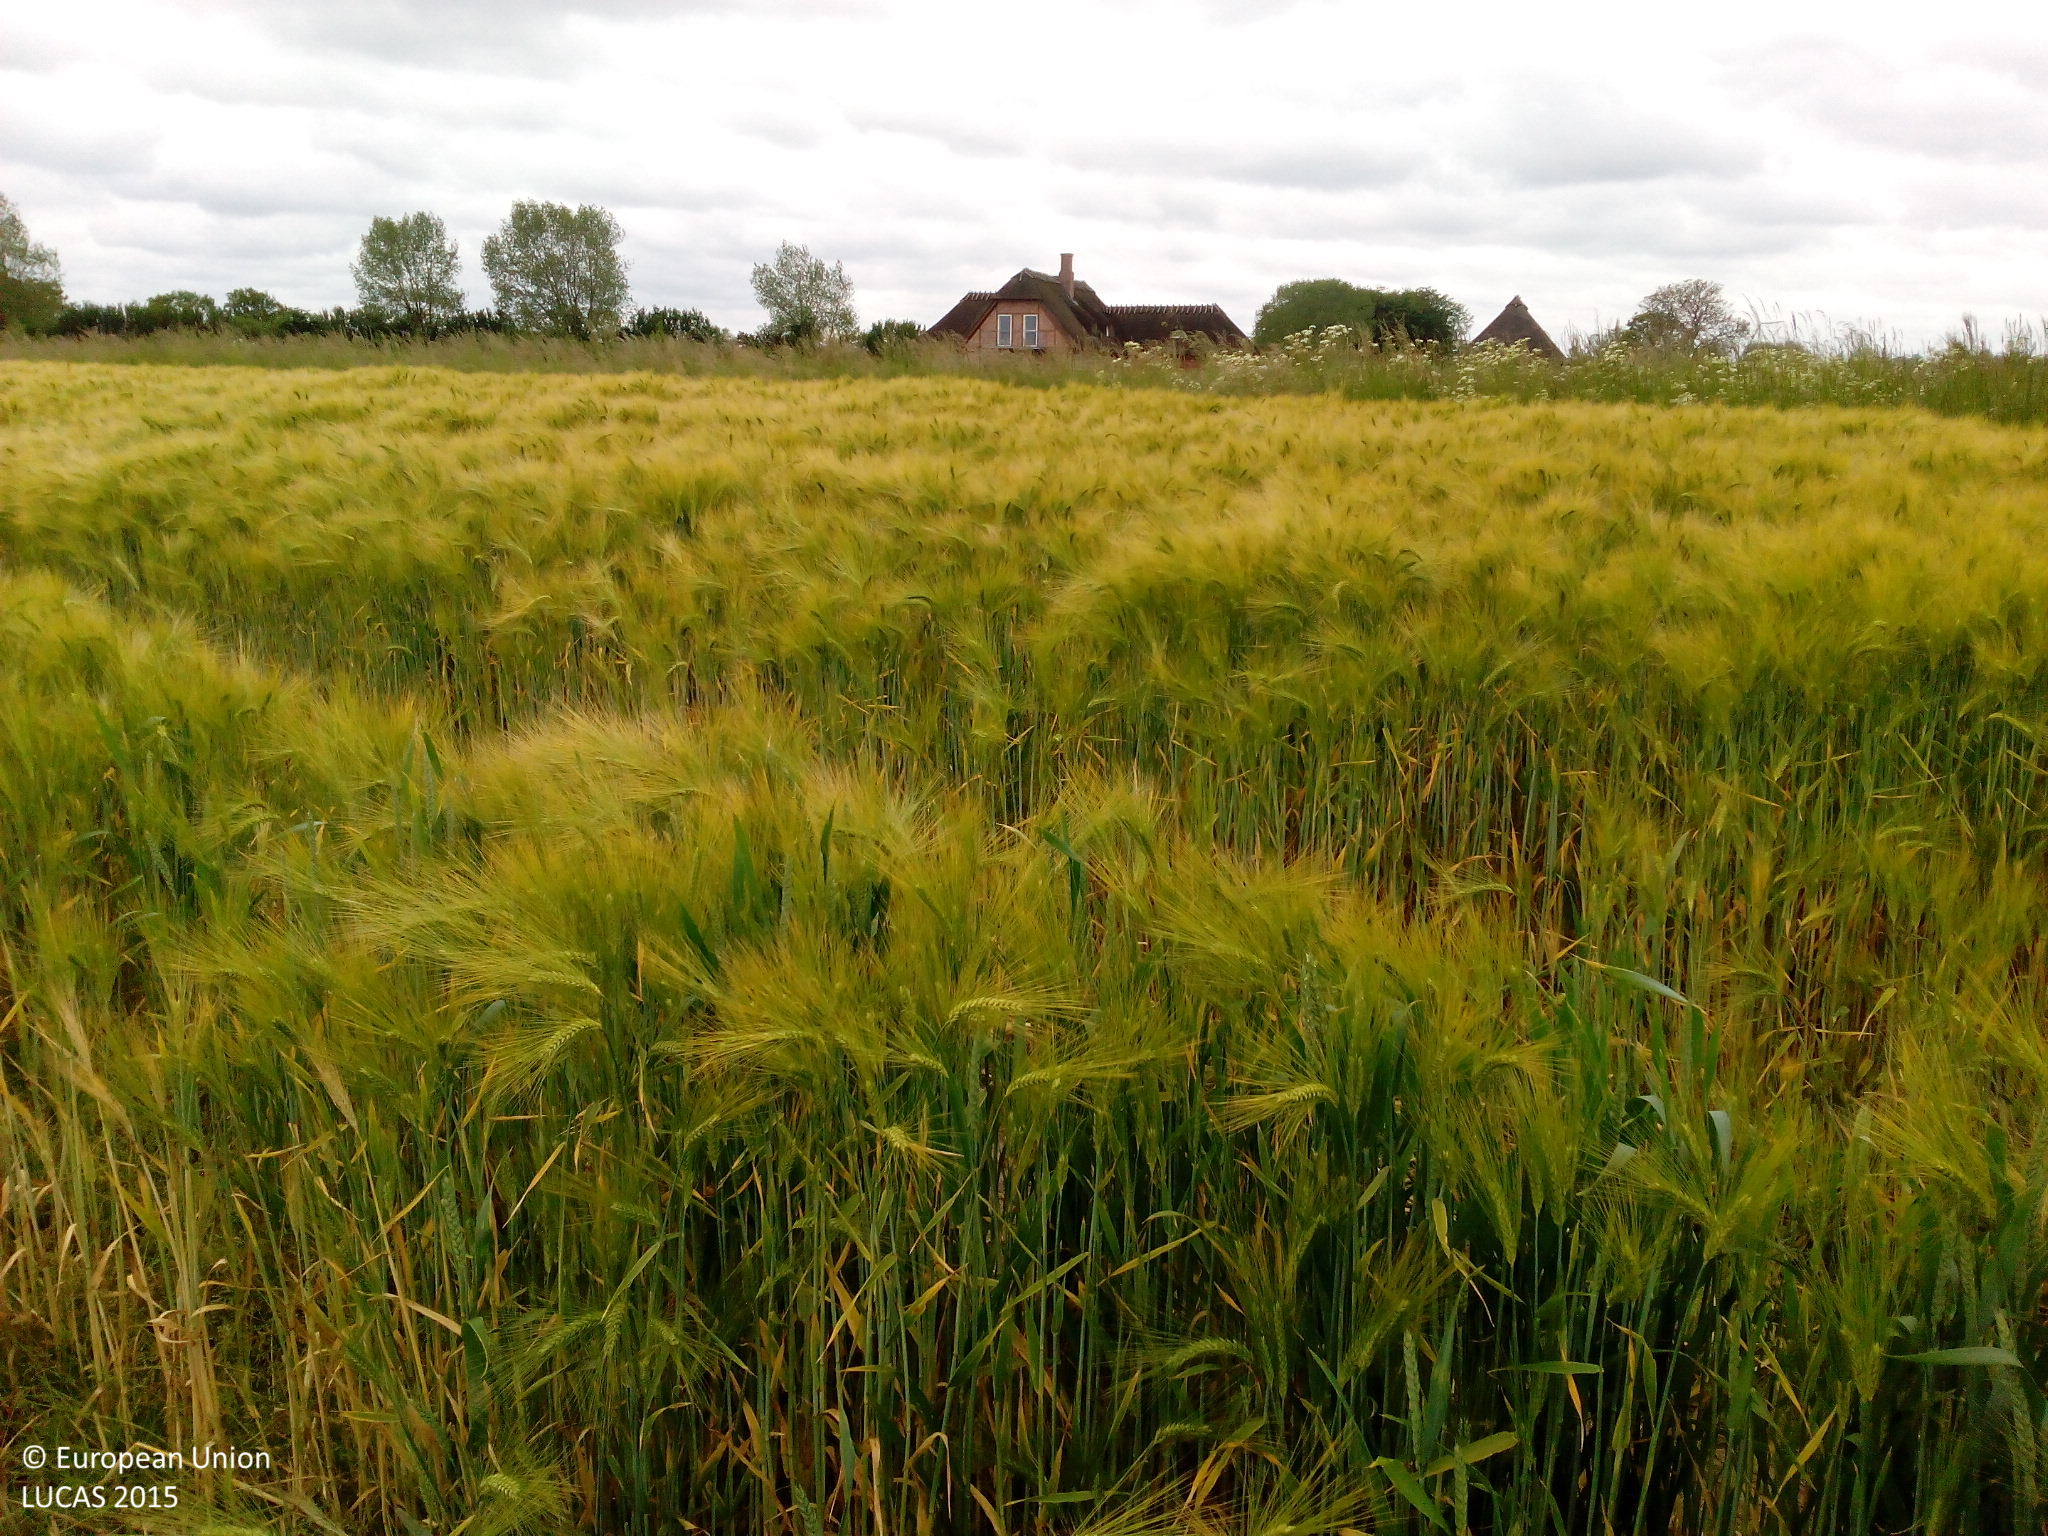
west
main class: Cropland
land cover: Barley
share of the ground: > 75 %
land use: Agriculture (excluding fallow land and kitchen gardens)
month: June
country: DK
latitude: 55.1968
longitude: 10.7691
